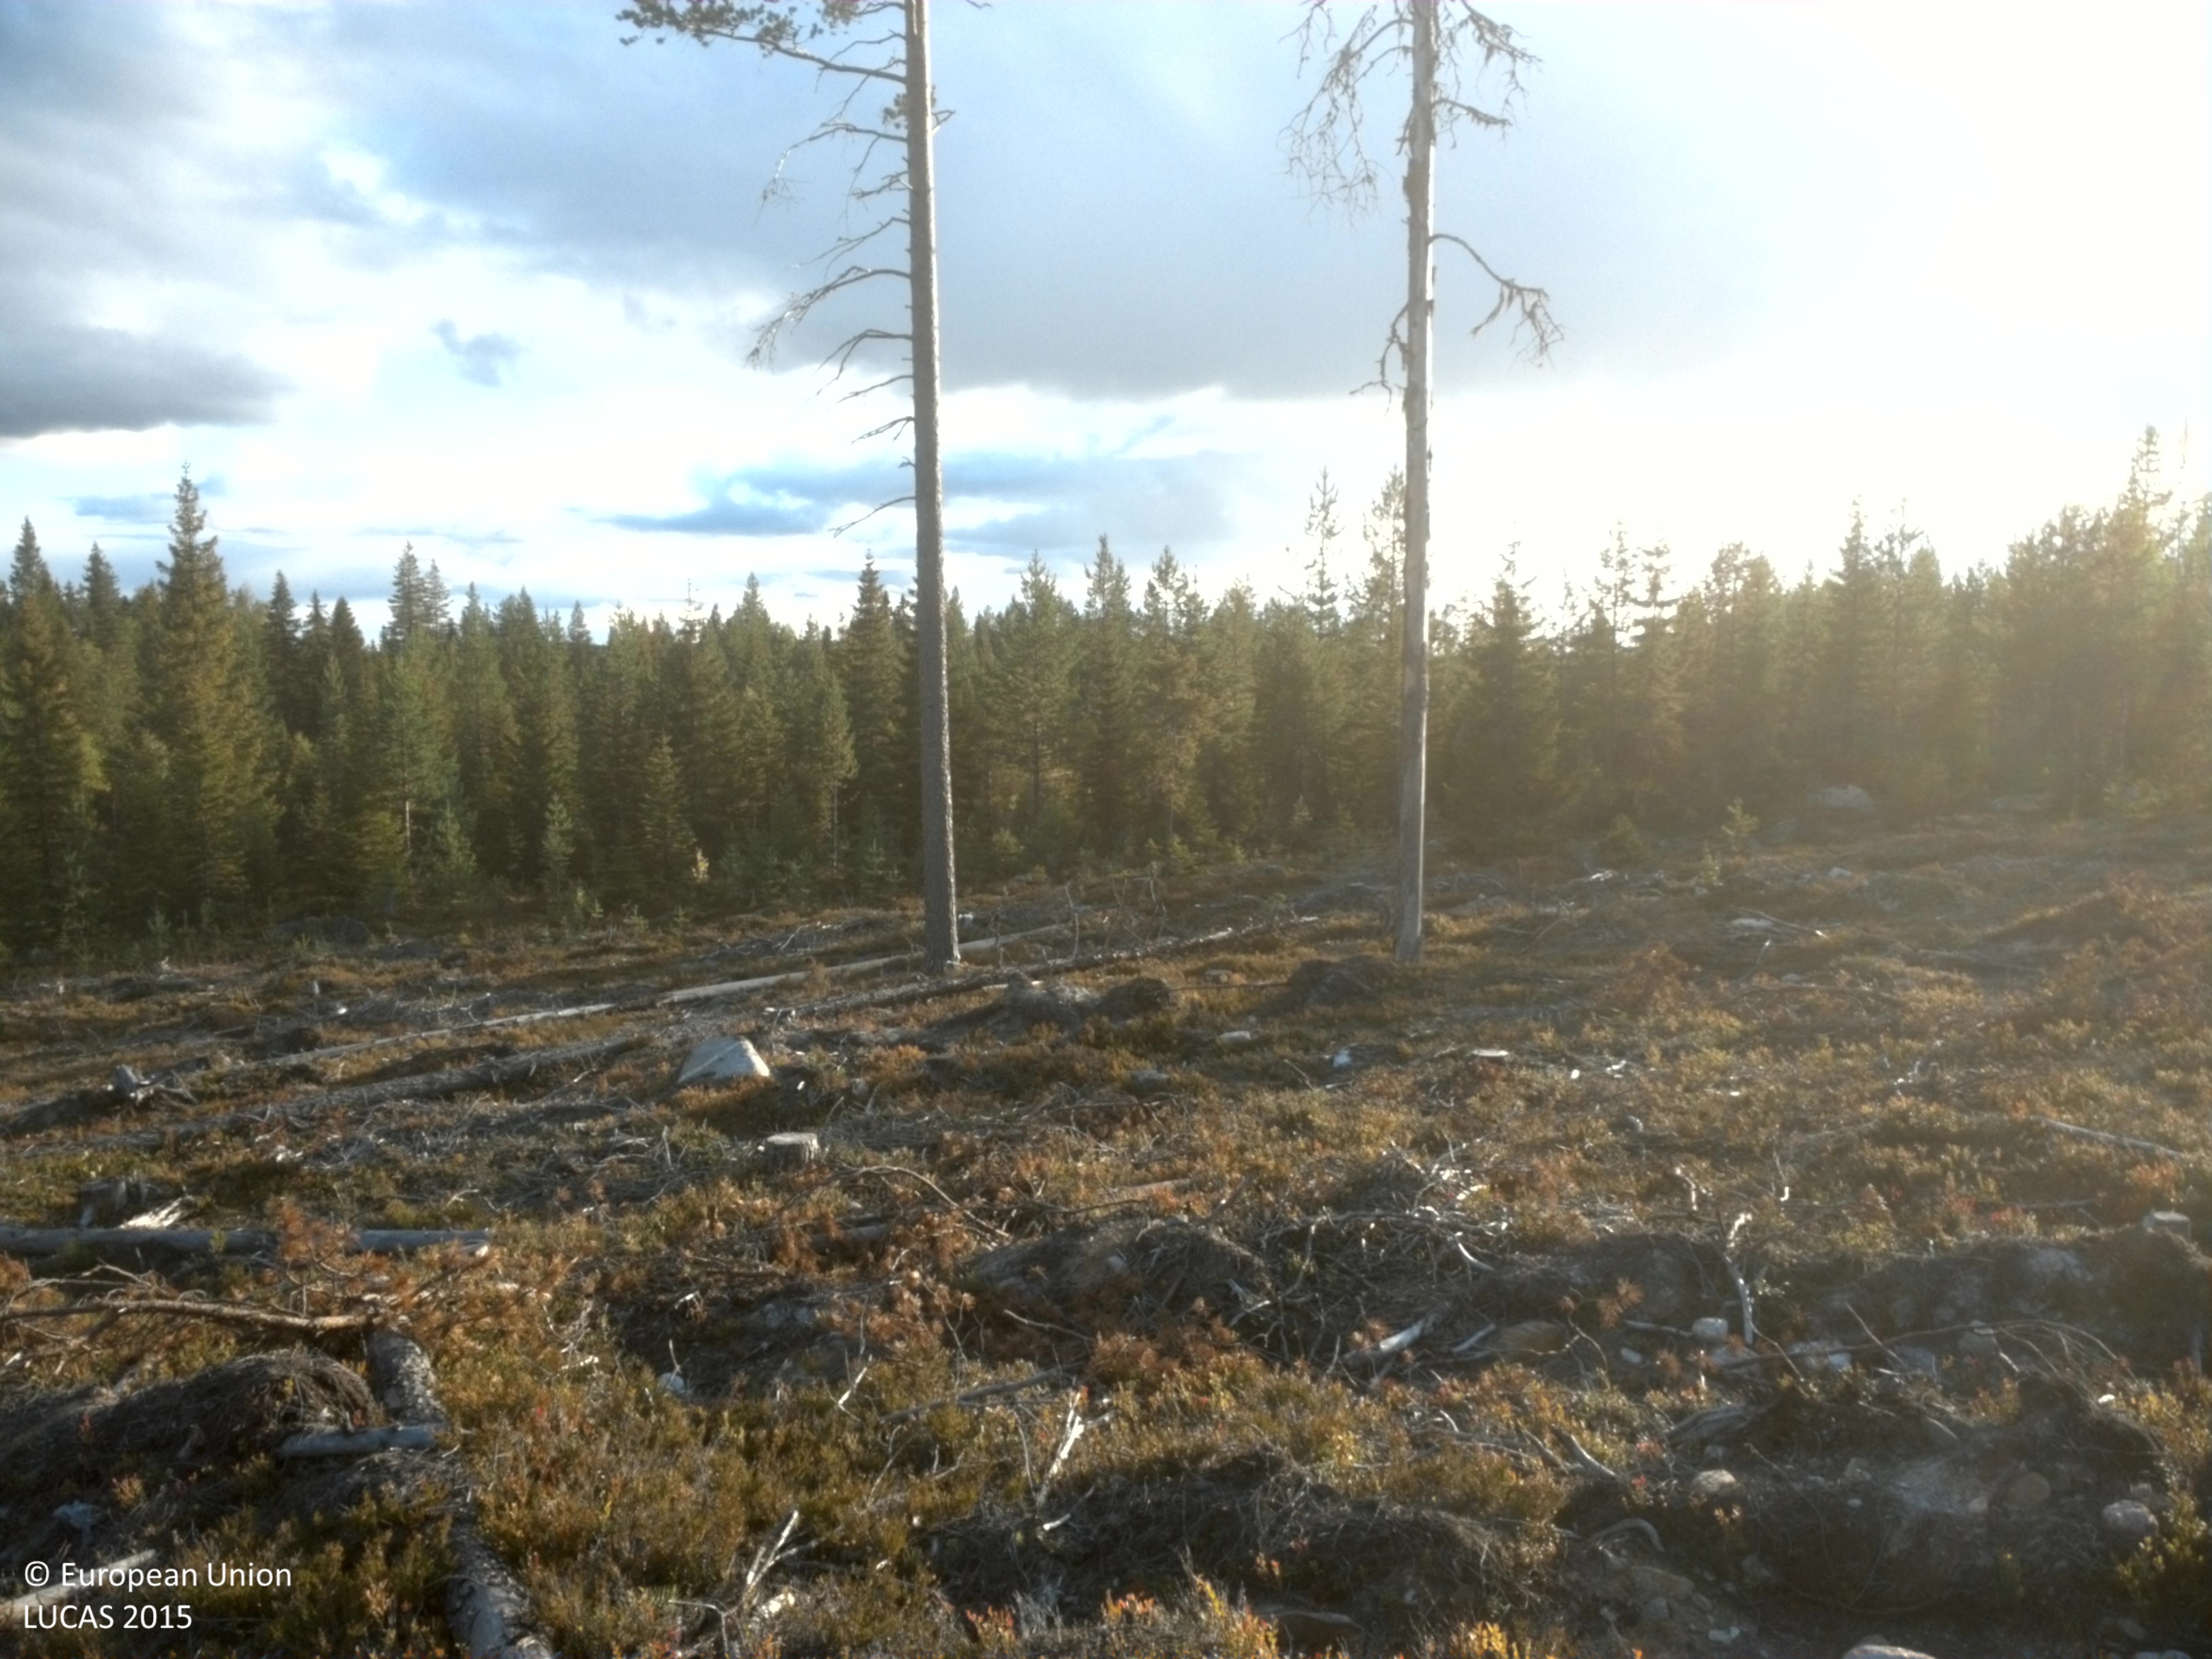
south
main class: Woodland
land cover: Pine dominated coniferous woodland
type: boreal forest
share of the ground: 10 - 25 %
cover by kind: shrubs 75 %, lichens and mosses 15 %, coniferous forest trees 10 %
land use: Forestry
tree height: > 5 m
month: September
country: SE
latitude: 64.4458
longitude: 19.7177
